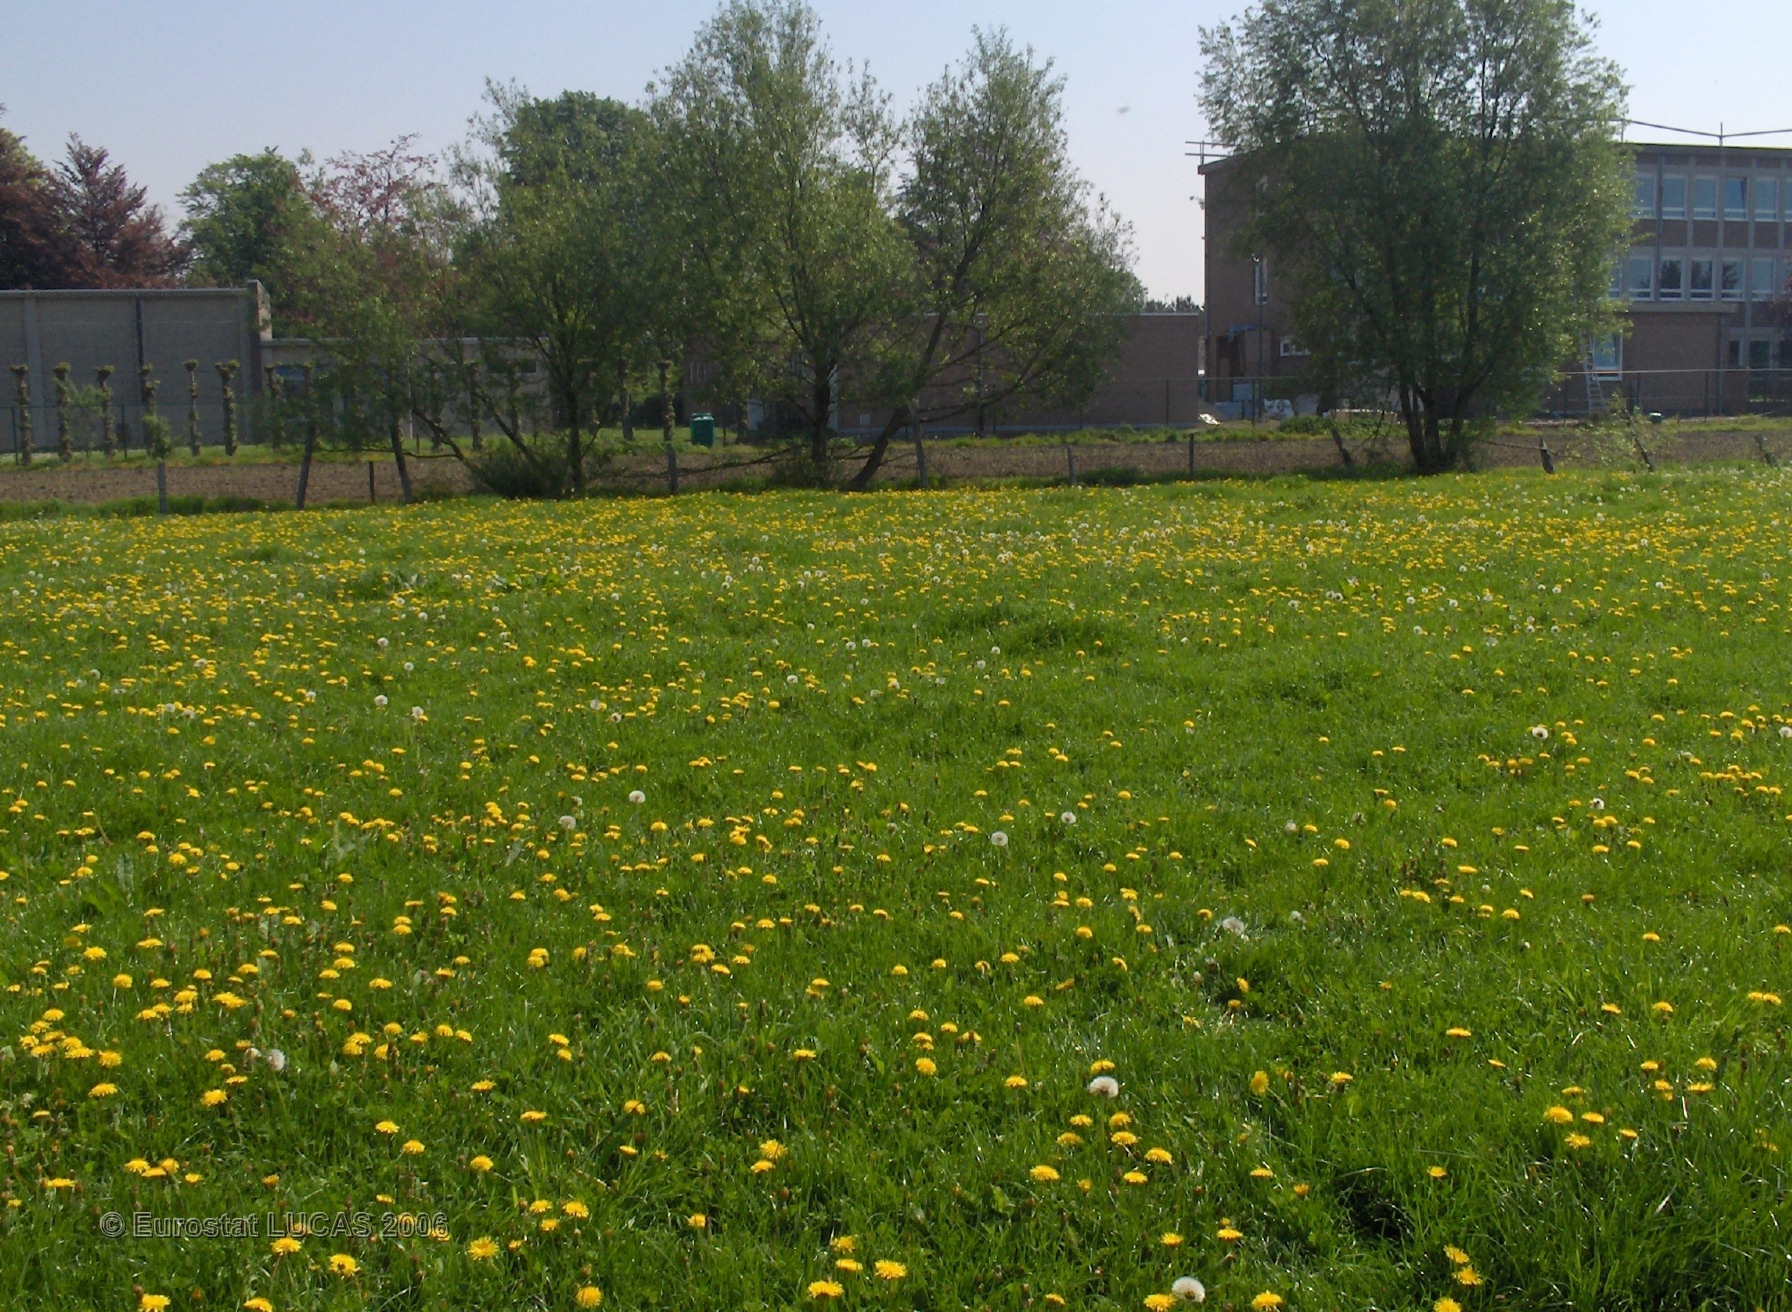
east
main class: Grassland
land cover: Grassland without tree/shrub cover
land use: Agriculture (excluding fallow land and kitchen gardens)
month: May
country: BE
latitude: 51.1262
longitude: 3.6630
